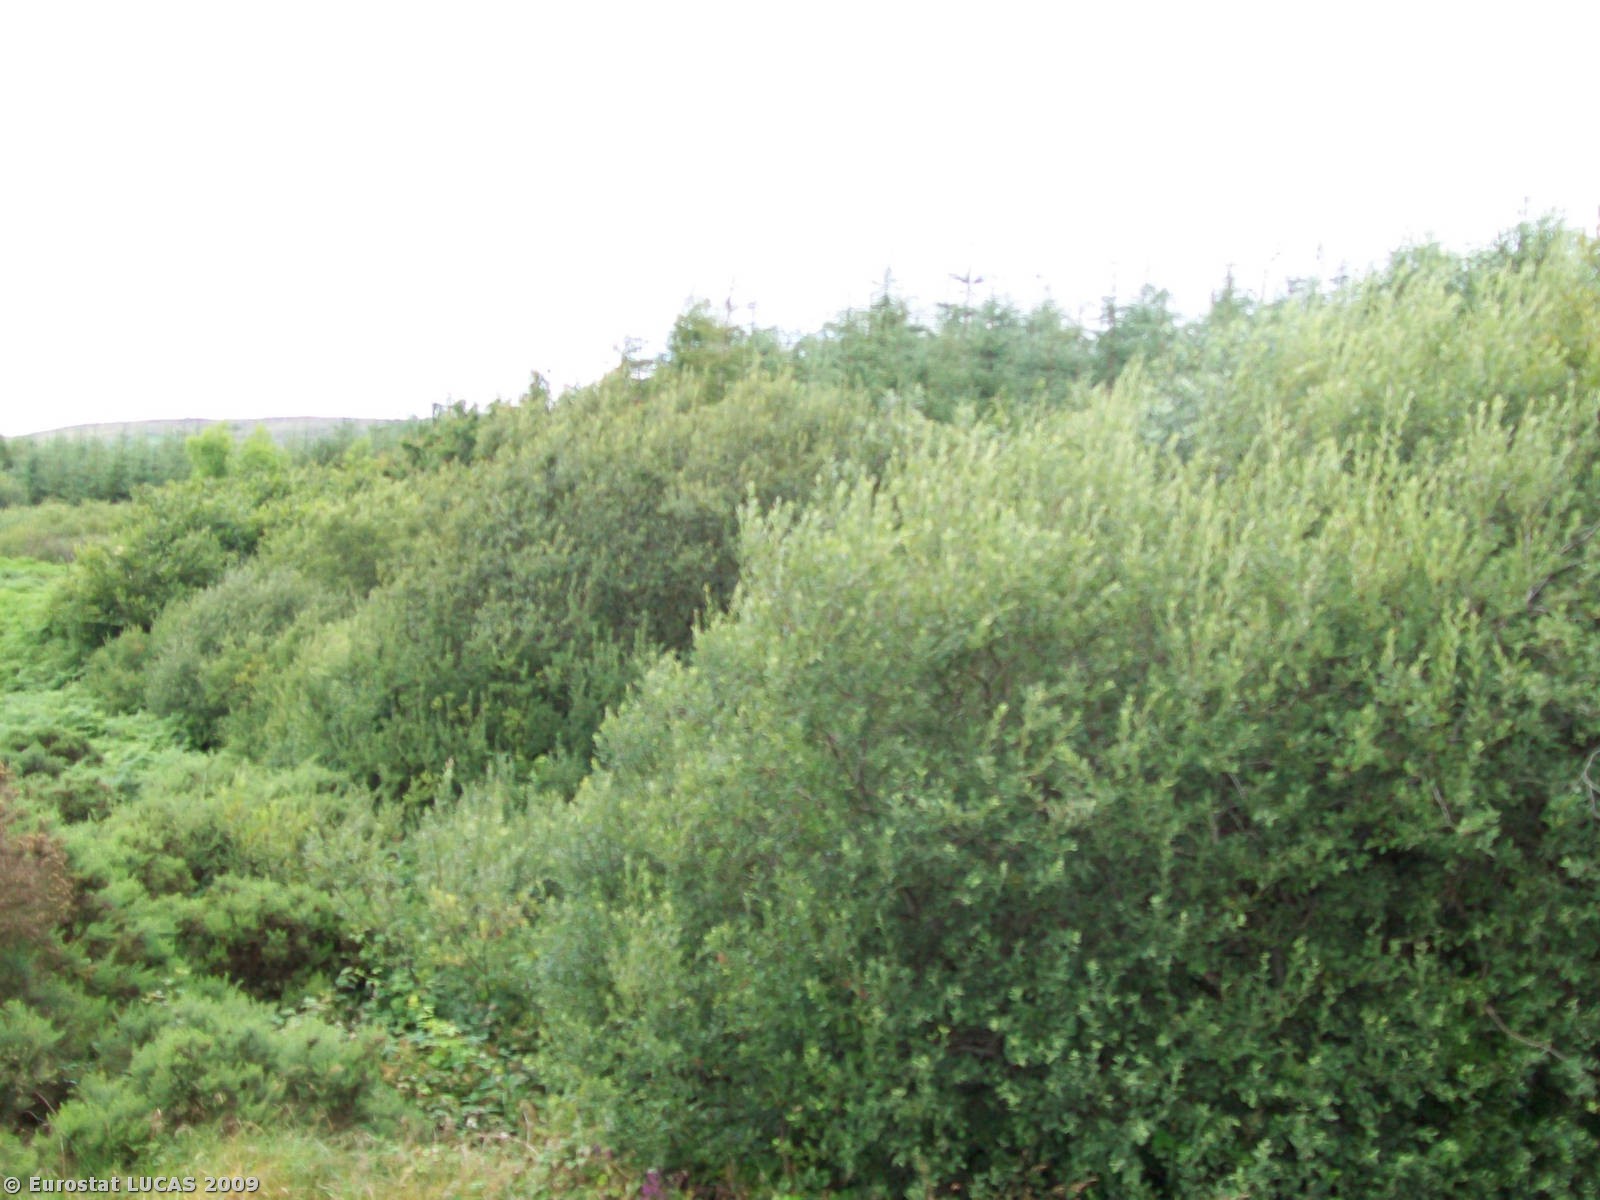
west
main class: Woodland
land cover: Coniferous woodland
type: plantations and self-sown exotic forest
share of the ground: > 75 %
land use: Forestry
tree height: > 5 m
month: July
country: IE
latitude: 53.9580
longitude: -9.0665
